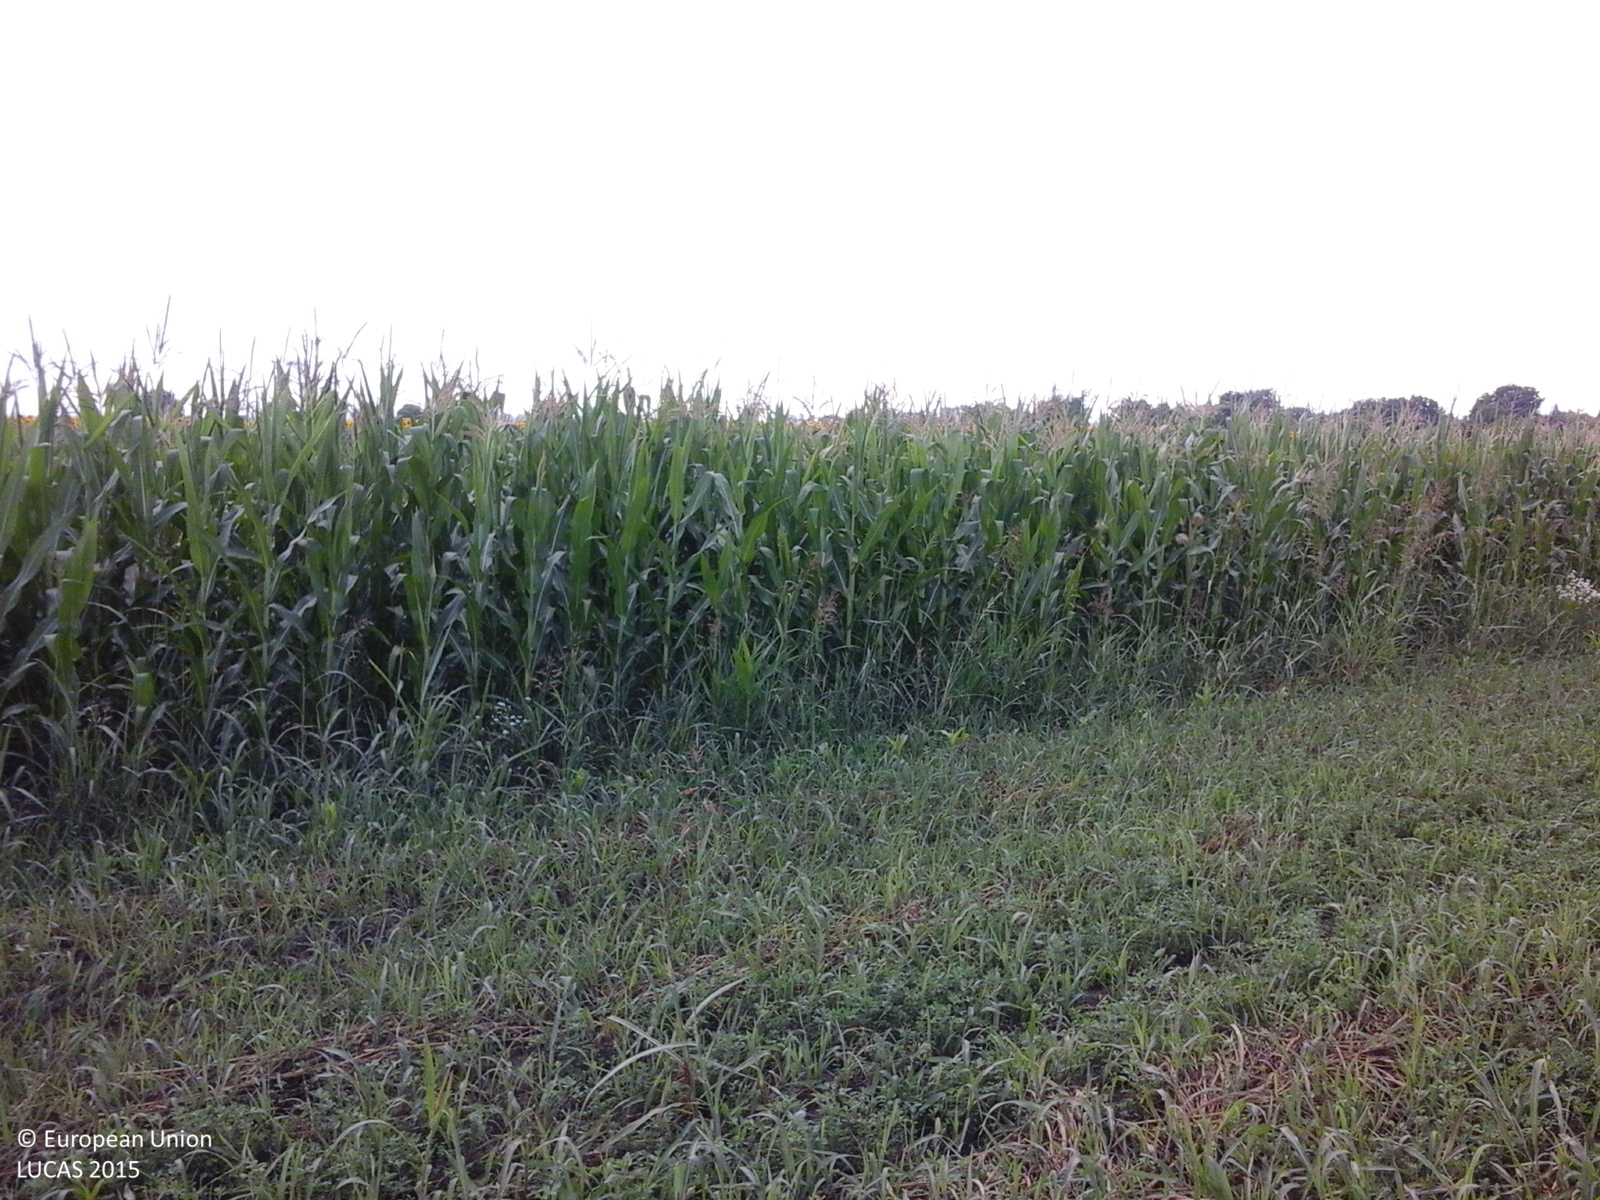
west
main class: Cropland
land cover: Lucerne
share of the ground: > 75 %
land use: Agriculture (excluding fallow land and kitchen gardens)
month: July
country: RO
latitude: 43.8487
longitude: 25.9047
